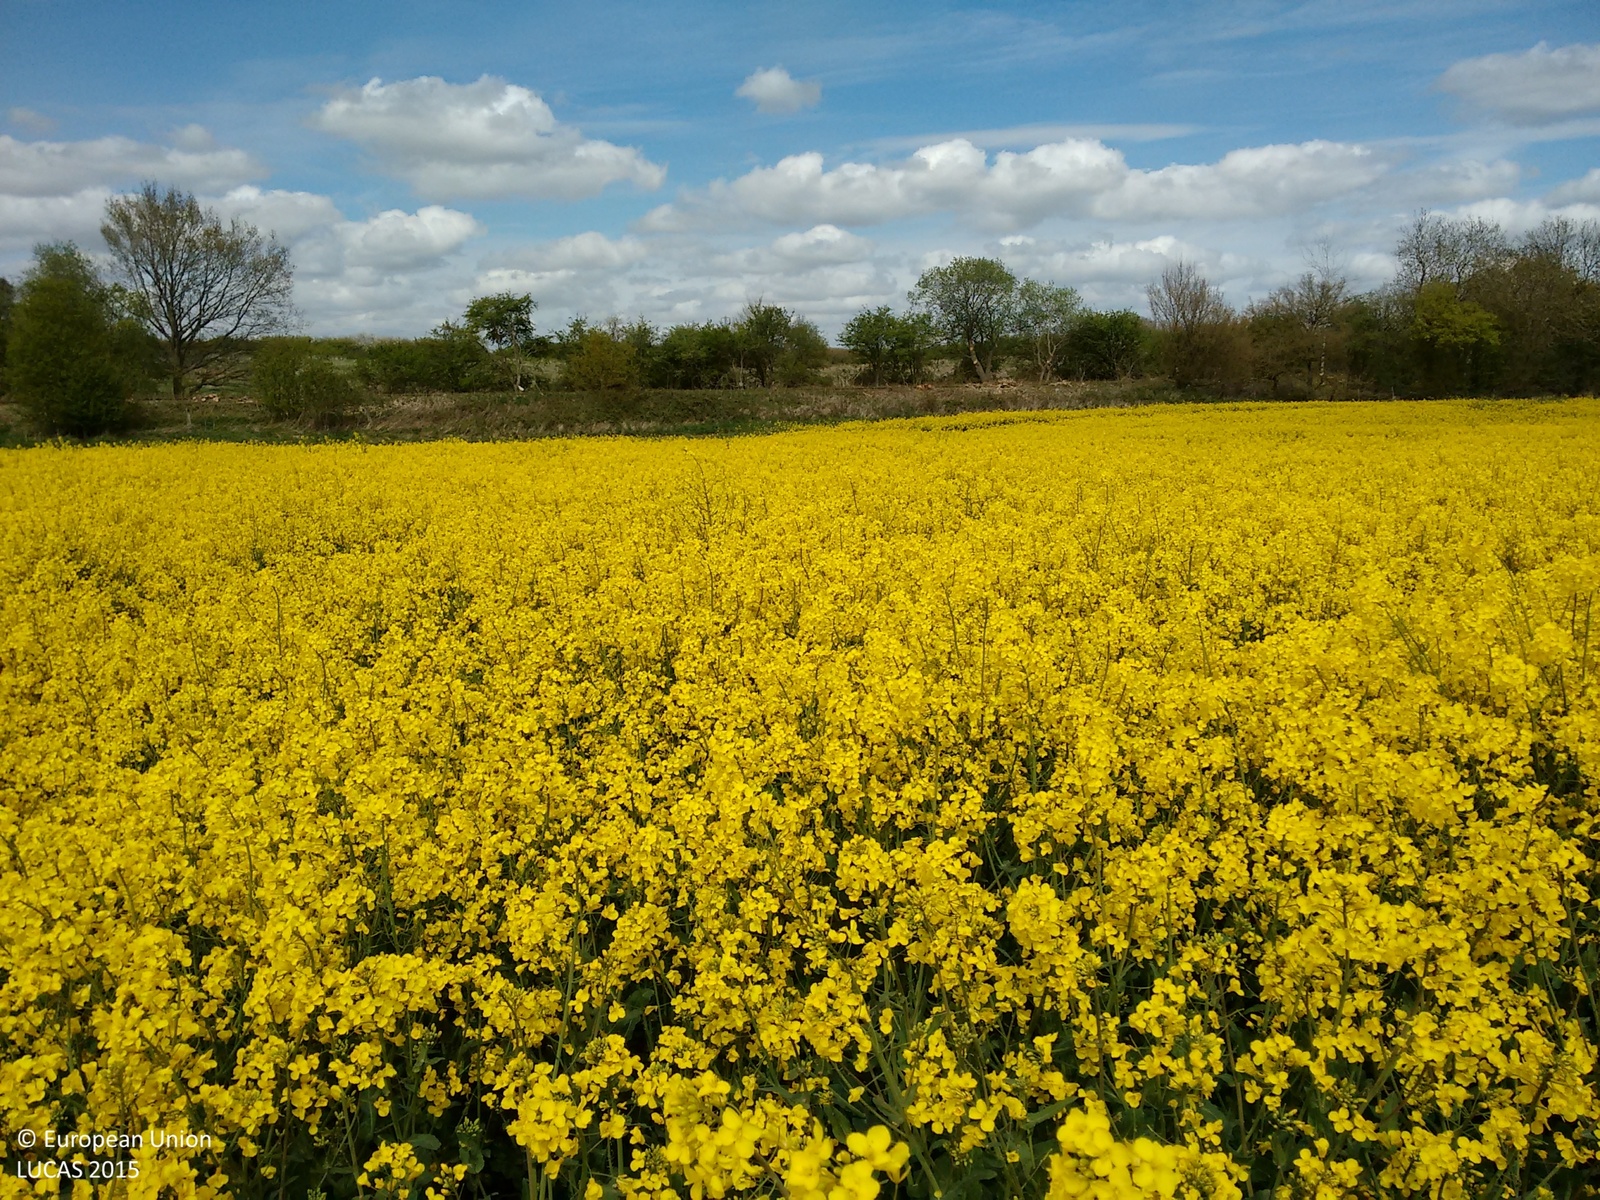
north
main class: Cropland
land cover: Rape and turnip rape
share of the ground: > 75 %
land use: Agriculture (excluding fallow land and kitchen gardens)
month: May
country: GB
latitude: 51.9739
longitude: -0.7998
